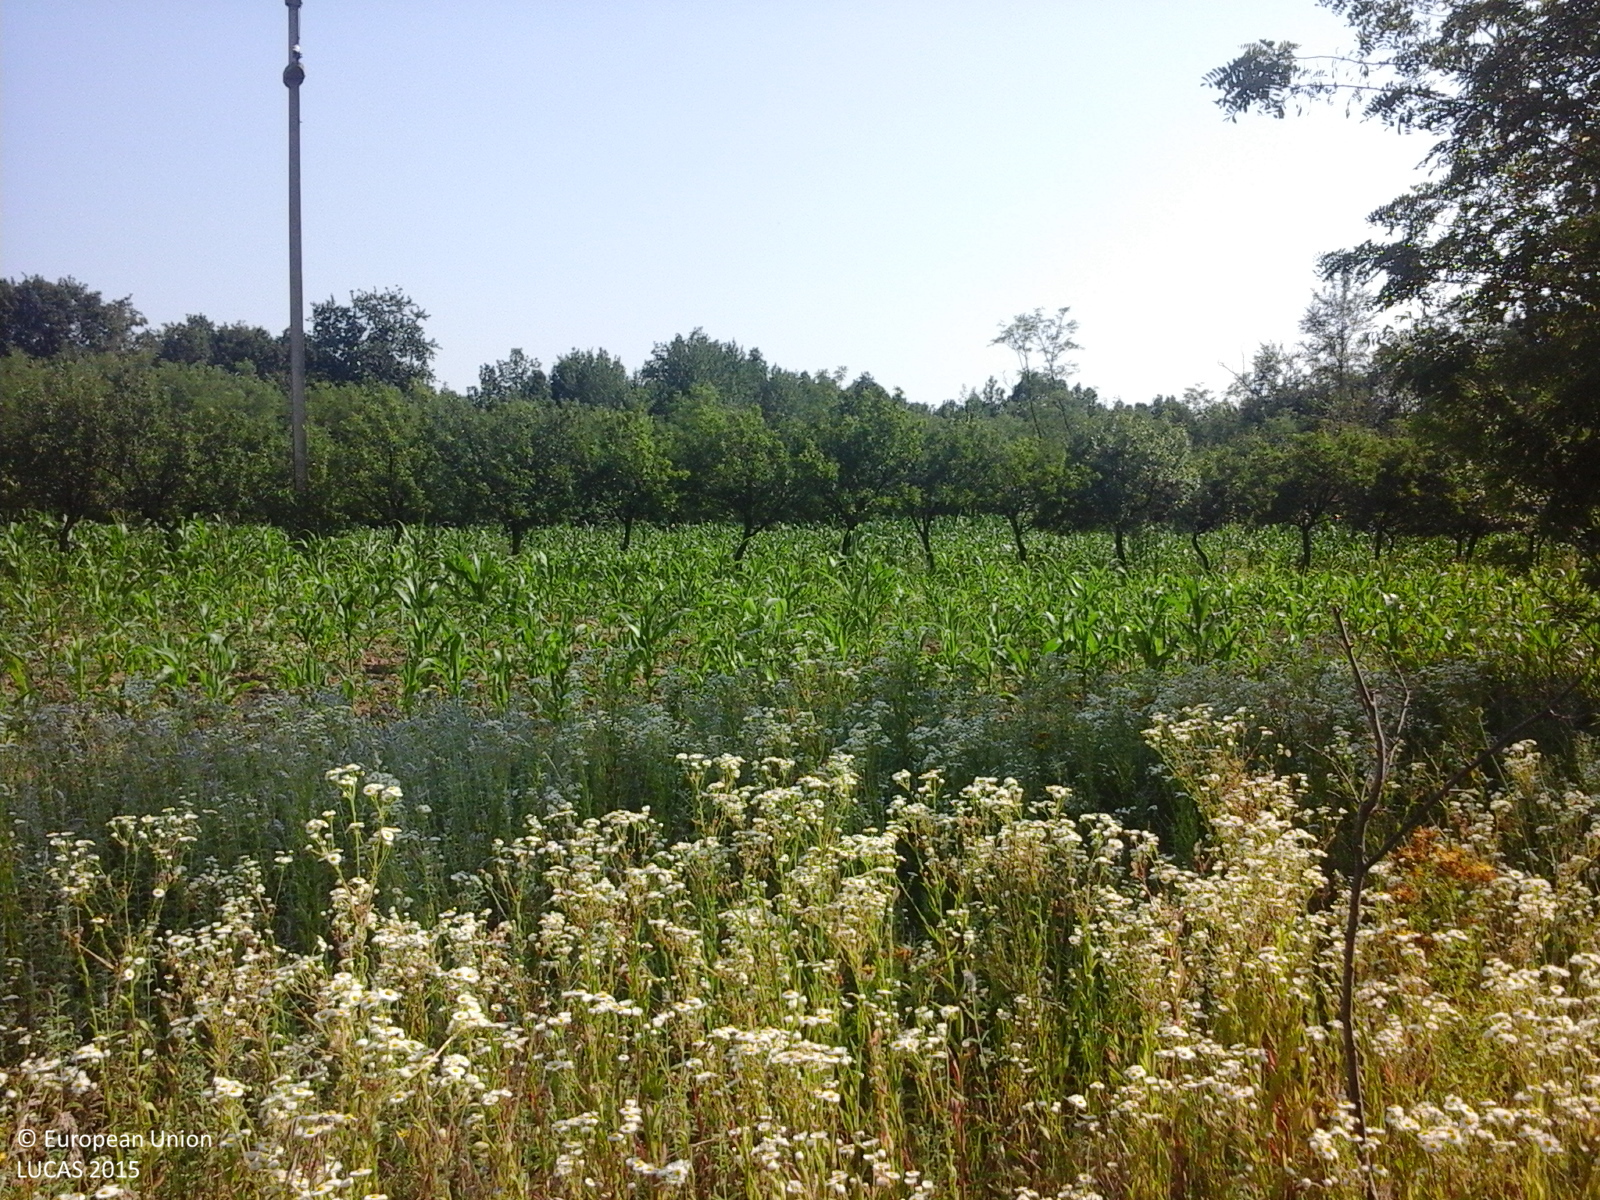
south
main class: Grassland
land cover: Spontaneously vegetated surfaces
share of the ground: > 75 %
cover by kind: herbaceous plants 100 %
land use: Agriculture (excluding fallow land and kitchen gardens)
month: July
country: RO
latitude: 44.7693
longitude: 24.6447
